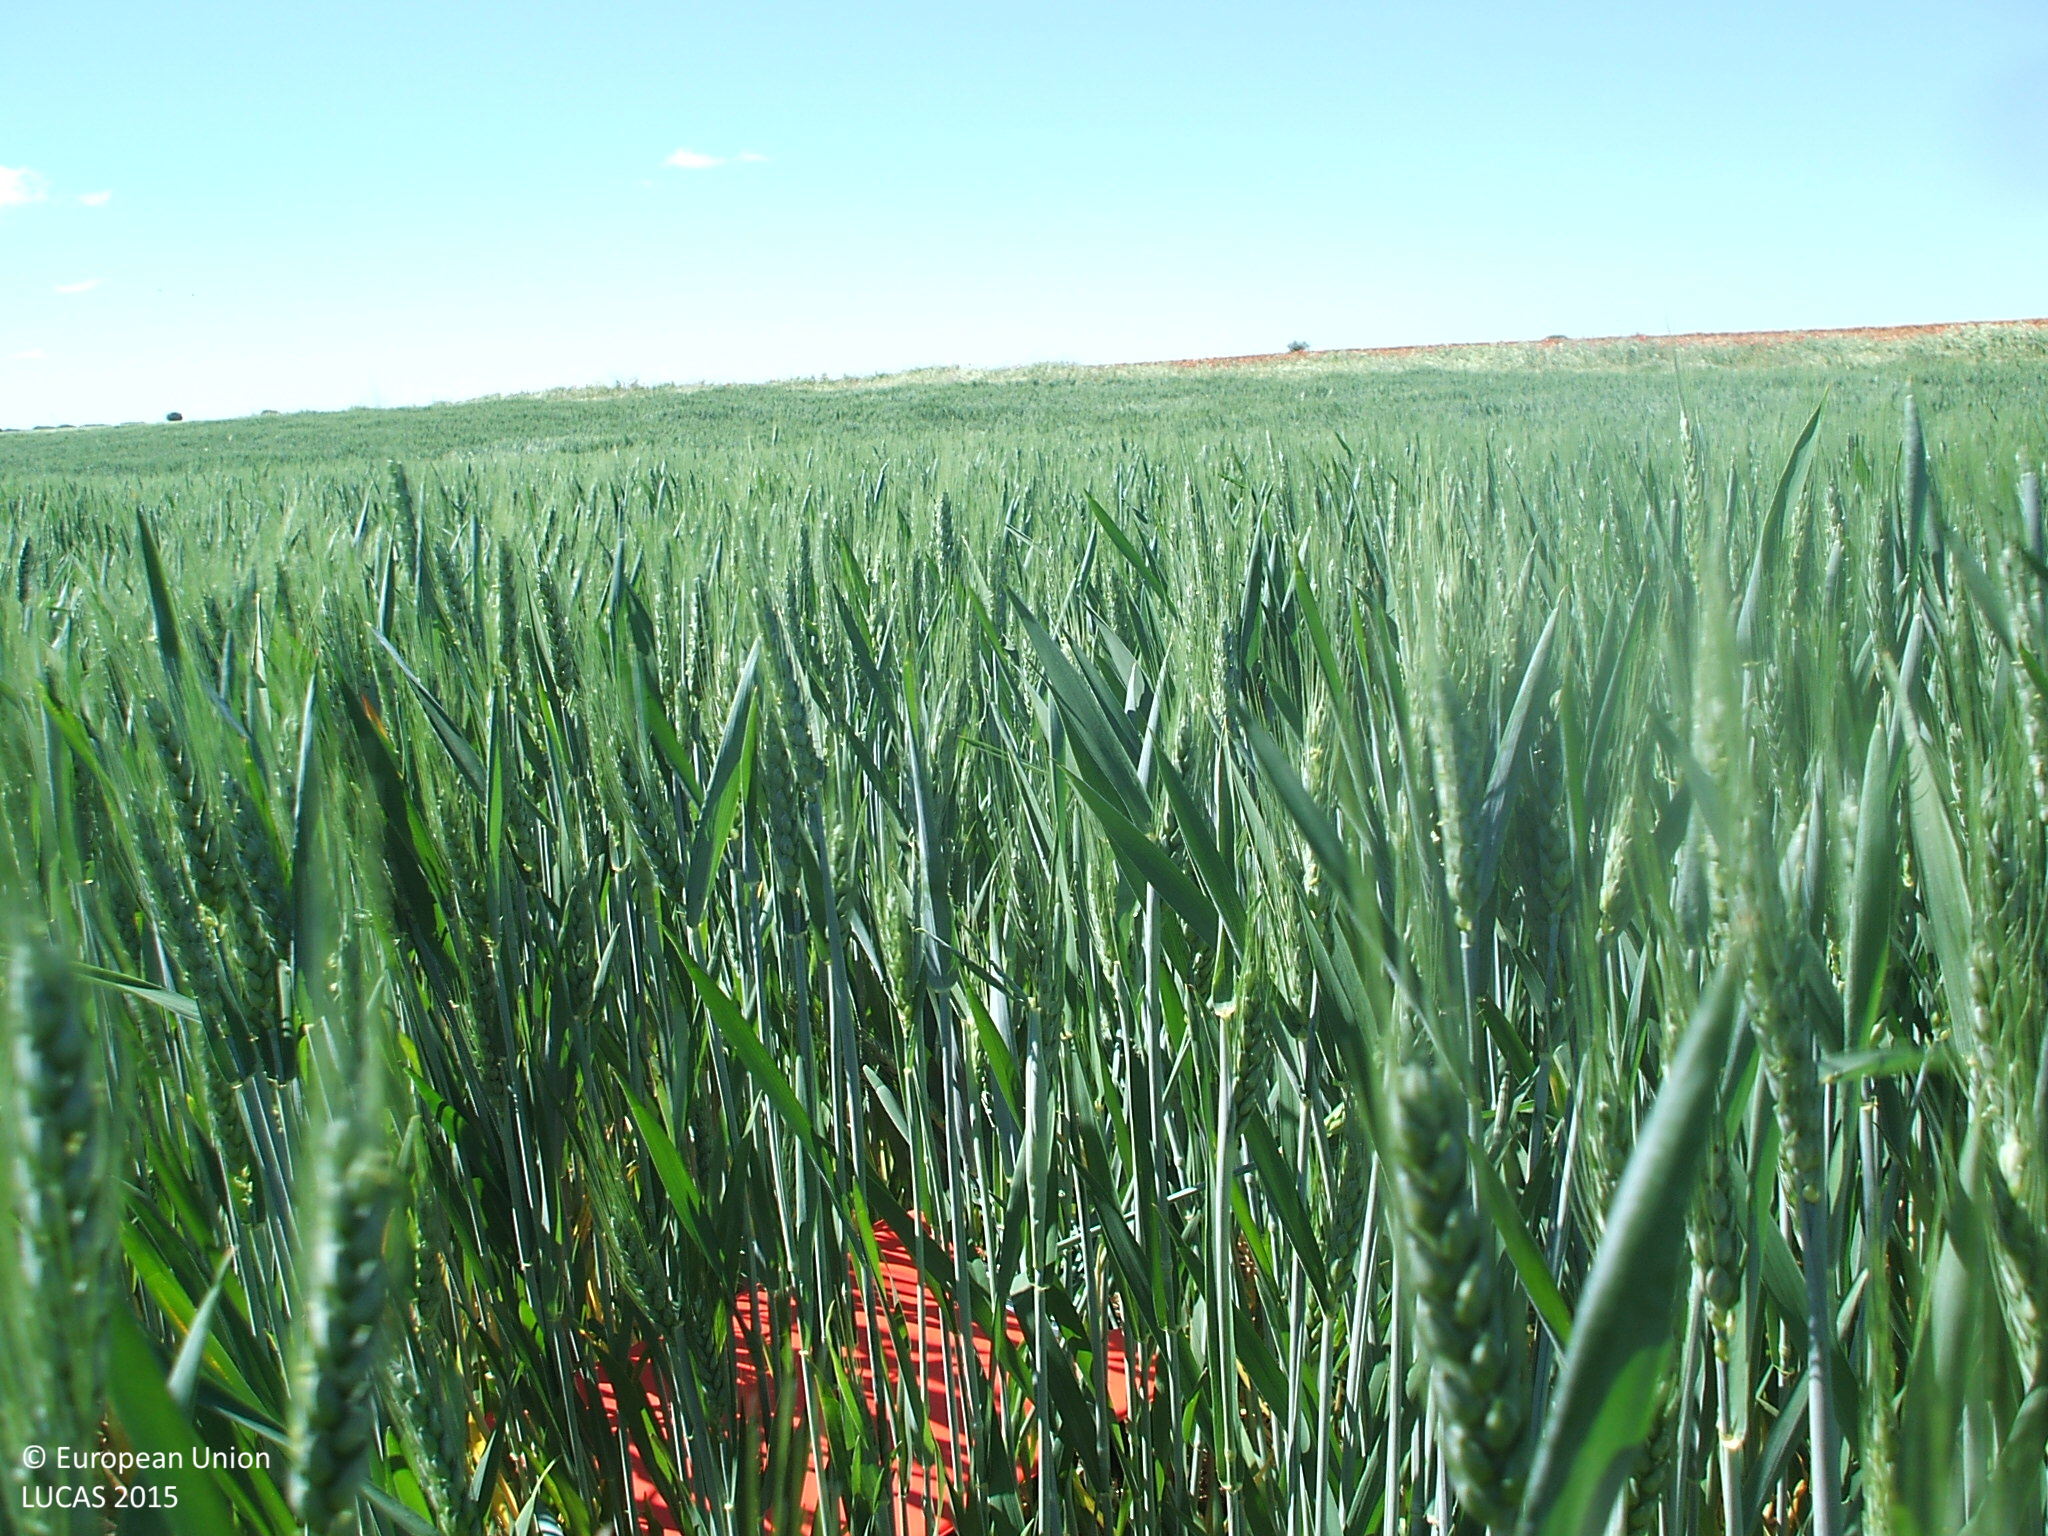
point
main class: Cropland
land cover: Common wheat
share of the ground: > 75 %
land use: Agriculture (excluding fallow land and kitchen gardens)
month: May
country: ES
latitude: 40.8771
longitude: -2.8844
